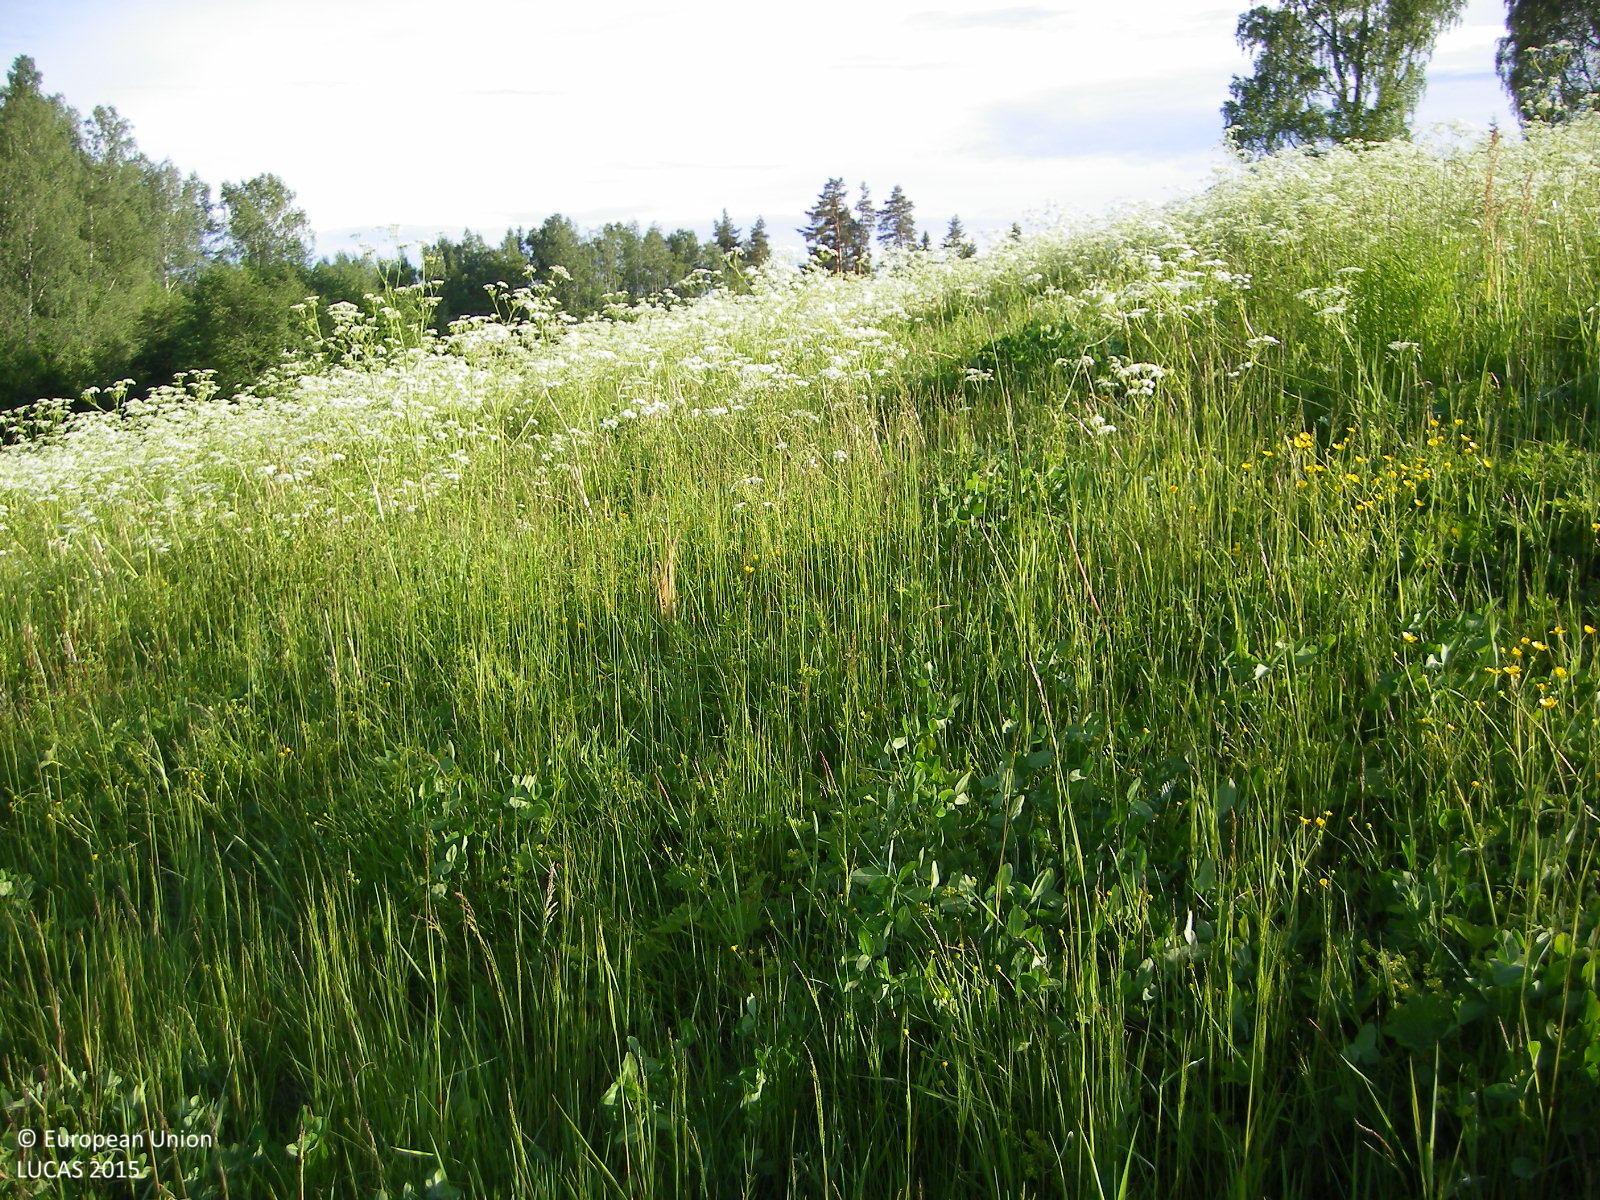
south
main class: Cropland
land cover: Other leguminous and mixtures for fodder
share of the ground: > 75 %
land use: Agriculture (excluding fallow land and kitchen gardens)
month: June
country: FI
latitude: 60.2941
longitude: 23.8990
